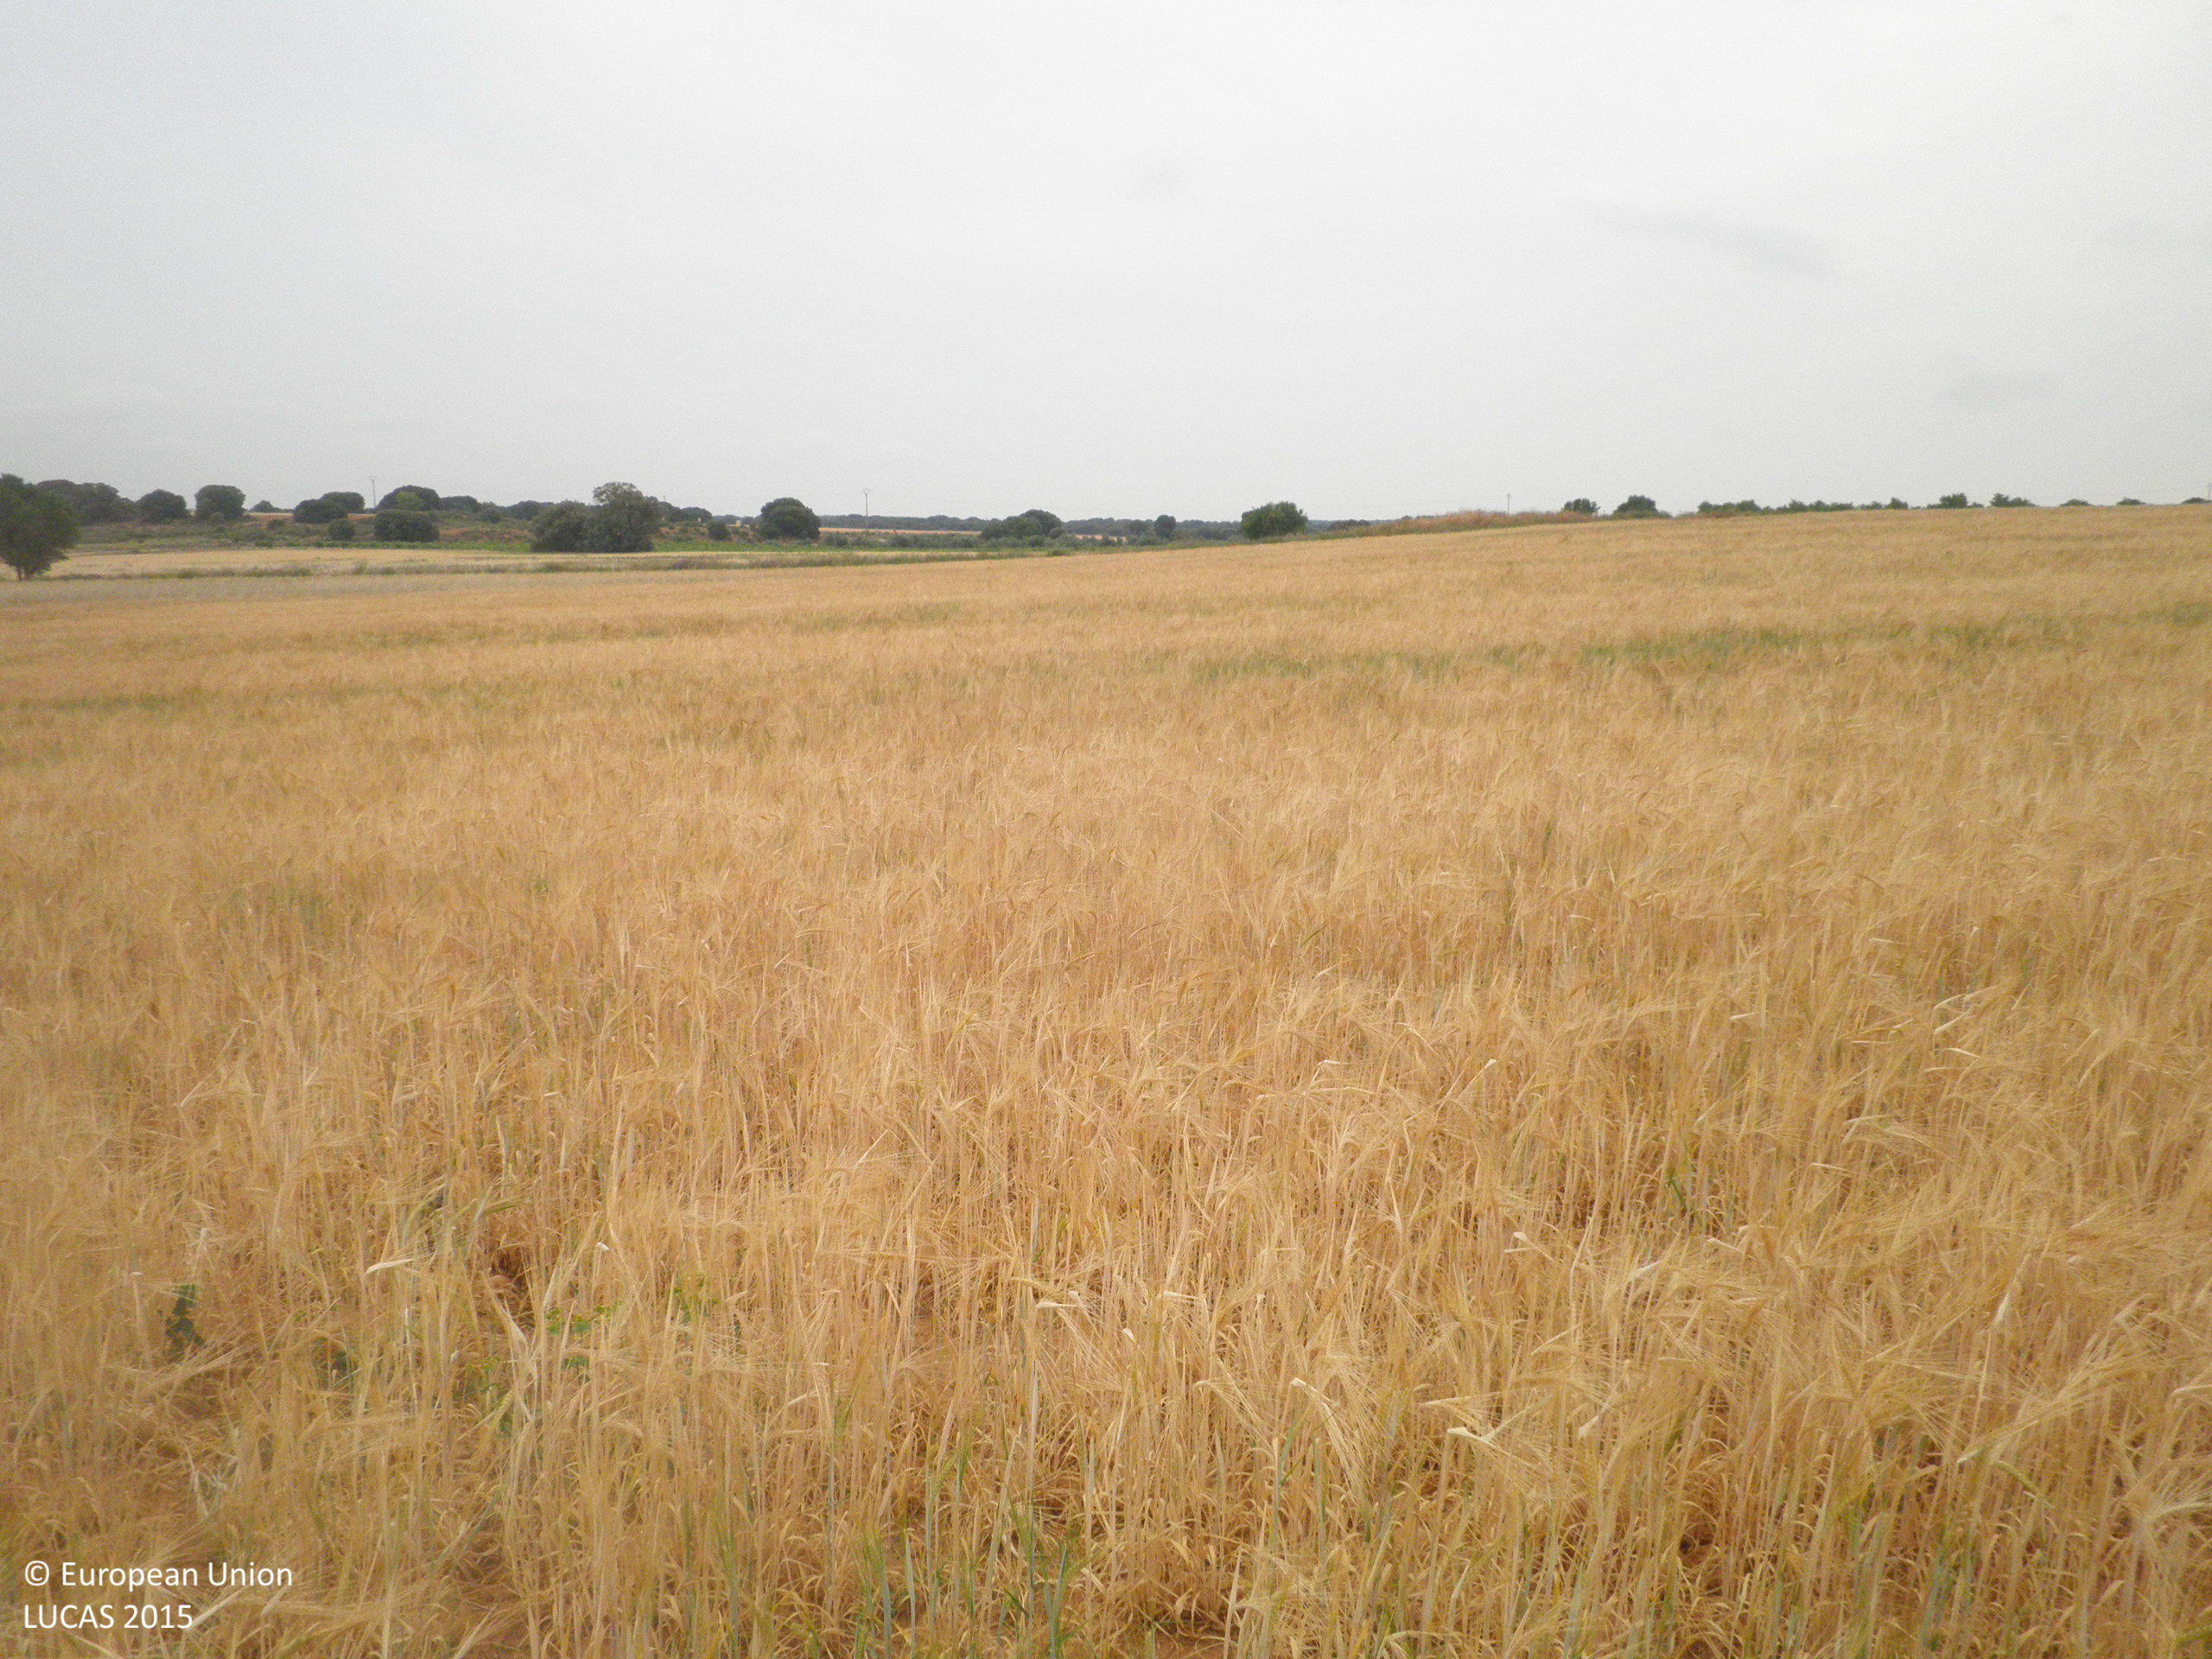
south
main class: Cropland
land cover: Barley
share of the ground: > 75 %
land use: Agriculture (excluding fallow land and kitchen gardens)
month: June
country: ES
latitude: 39.5257
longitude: -1.7206
